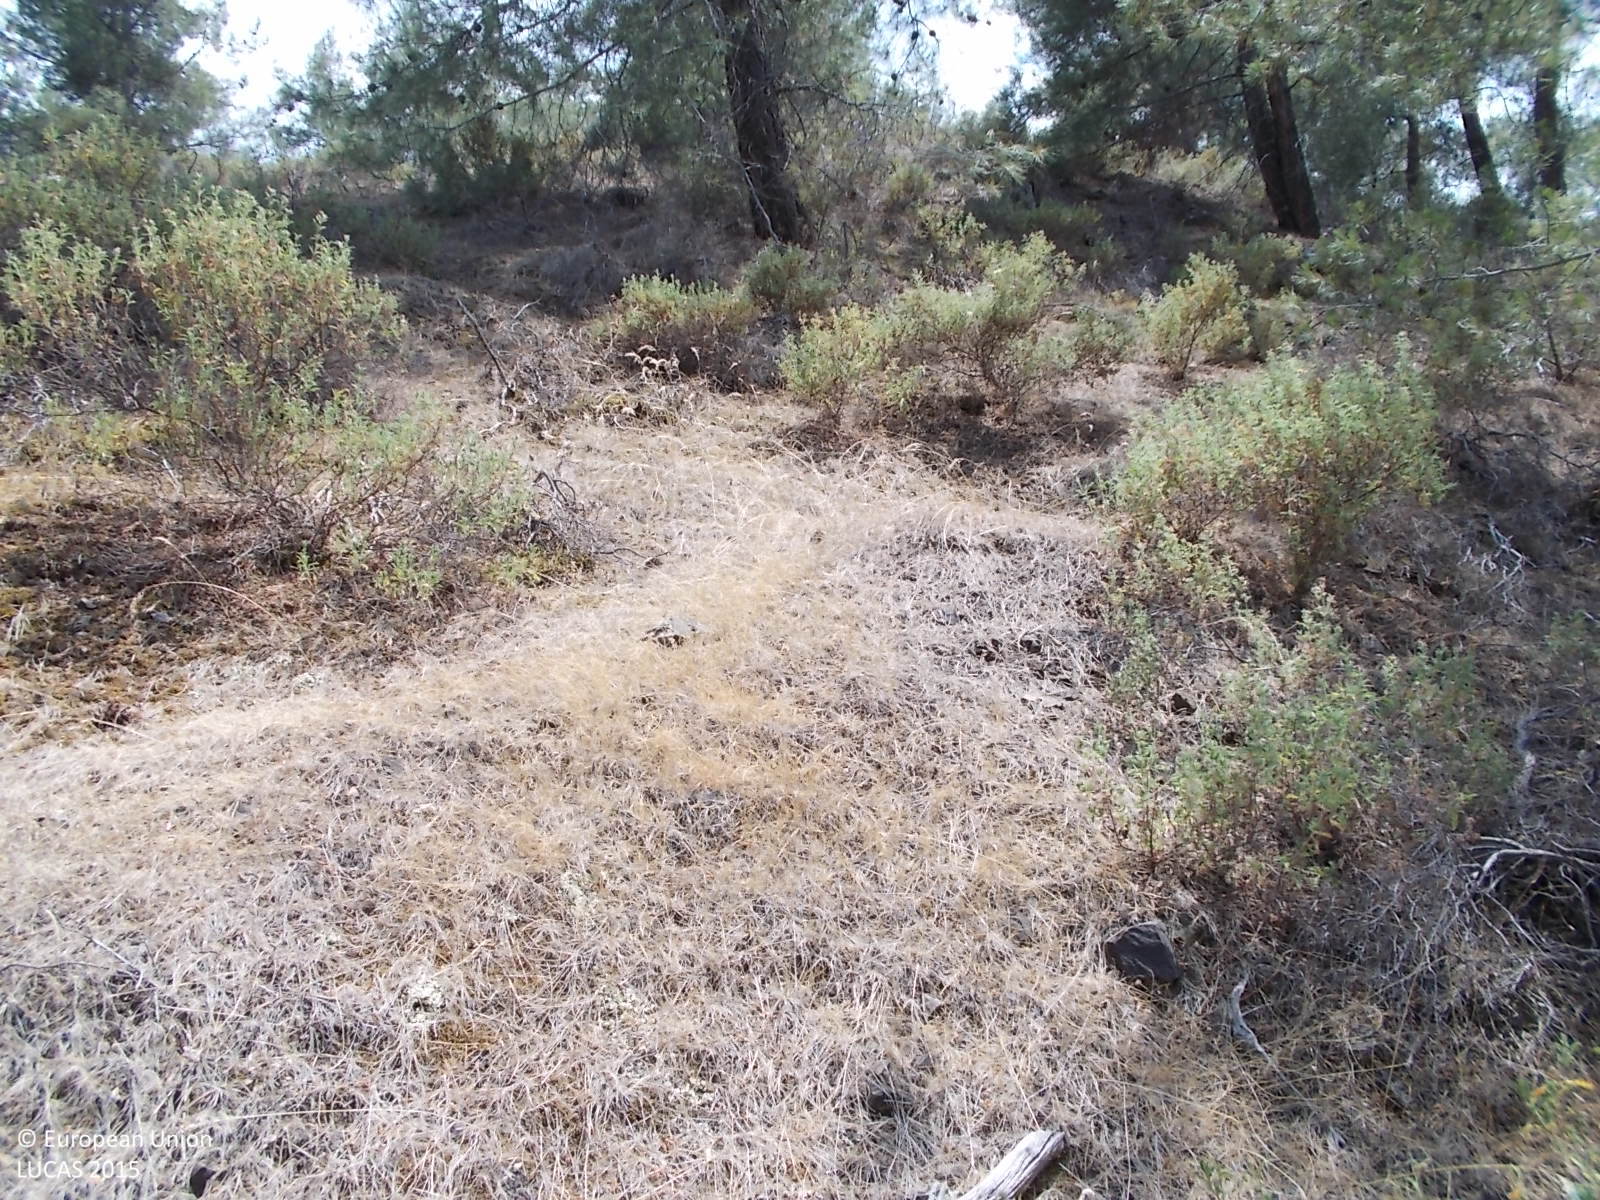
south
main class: Woodland
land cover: Pine dominated coniferous woodland
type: coniferous forest of the mediterranean region
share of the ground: 10 - 25 %
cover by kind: herbaceous plants 45 %, shrubs 30 %, coniferous forest trees 20 %, unconsolidated bare surface 5 %
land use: Forestry
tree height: > 5 m
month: June
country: CY
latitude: 35.0171
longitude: 32.9338
